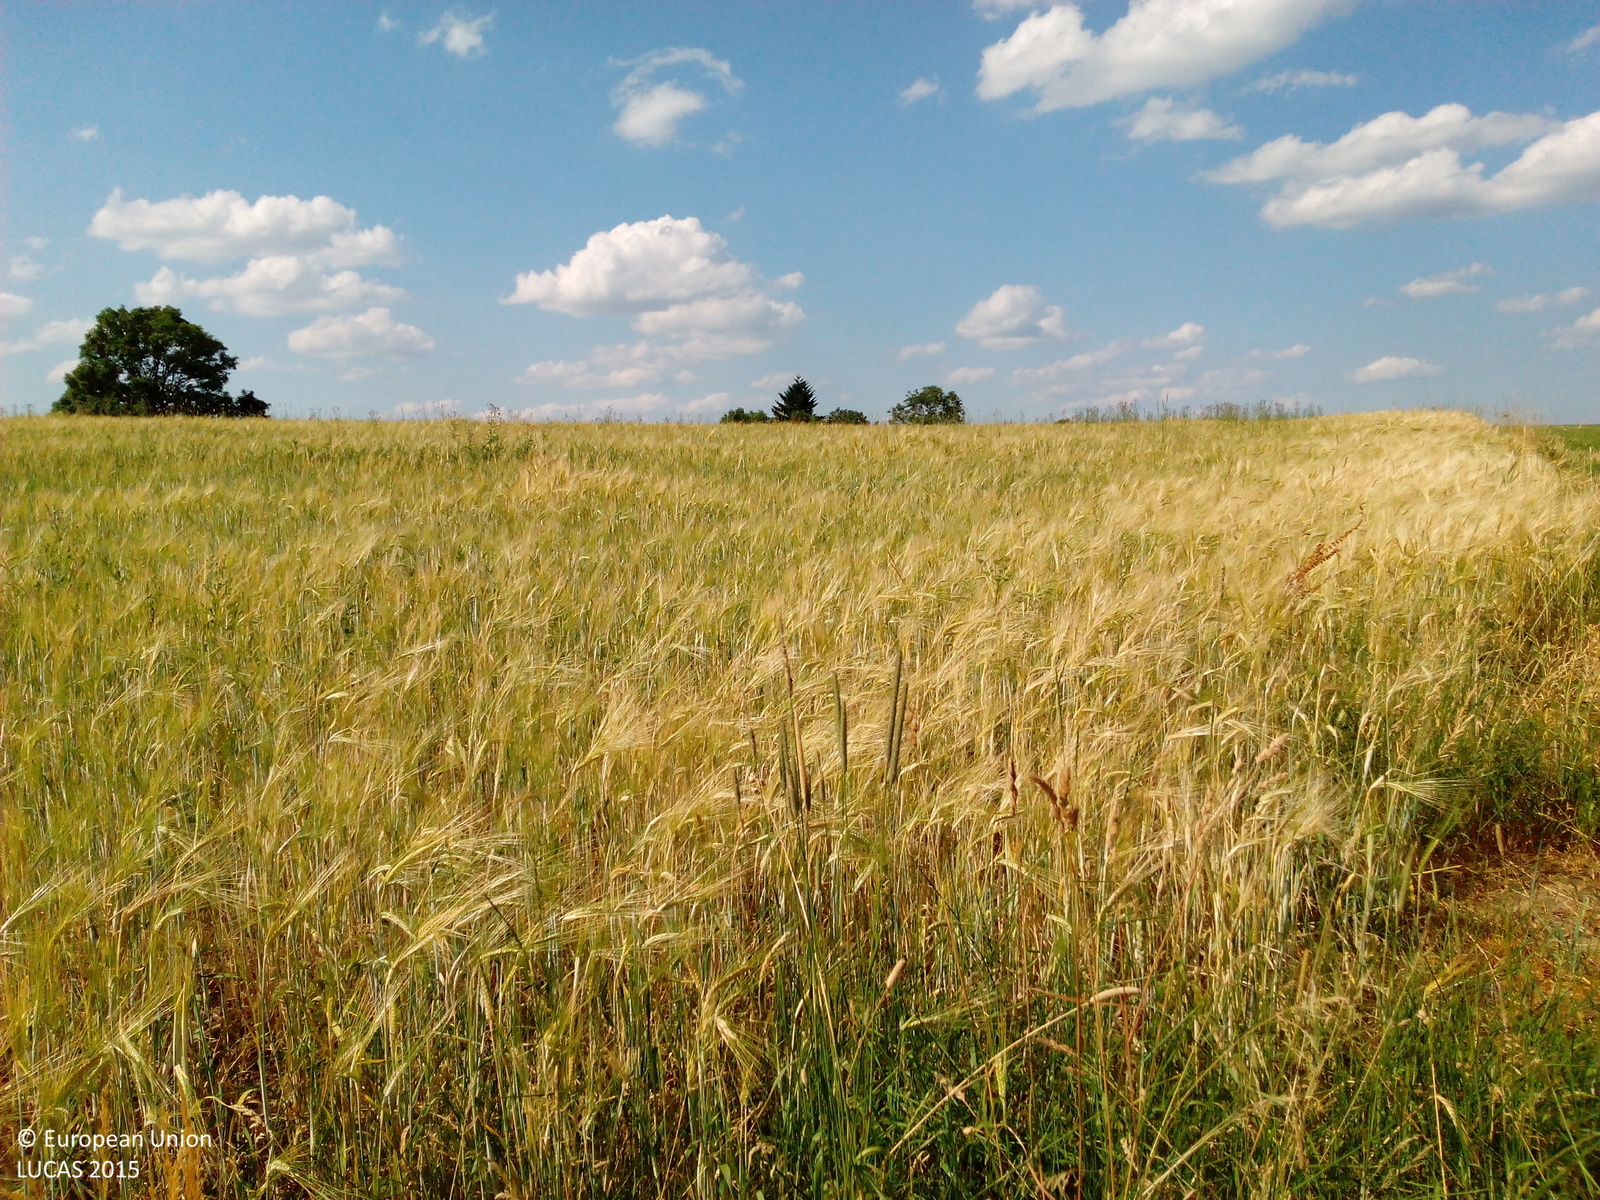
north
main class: Grassland
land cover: Grassland without tree/shrub cover
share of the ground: > 75 %
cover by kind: herbaceous plants 100 %
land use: Agriculture (excluding fallow land and kitchen gardens)
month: July
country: DE
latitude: 48.0166
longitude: 8.5932
